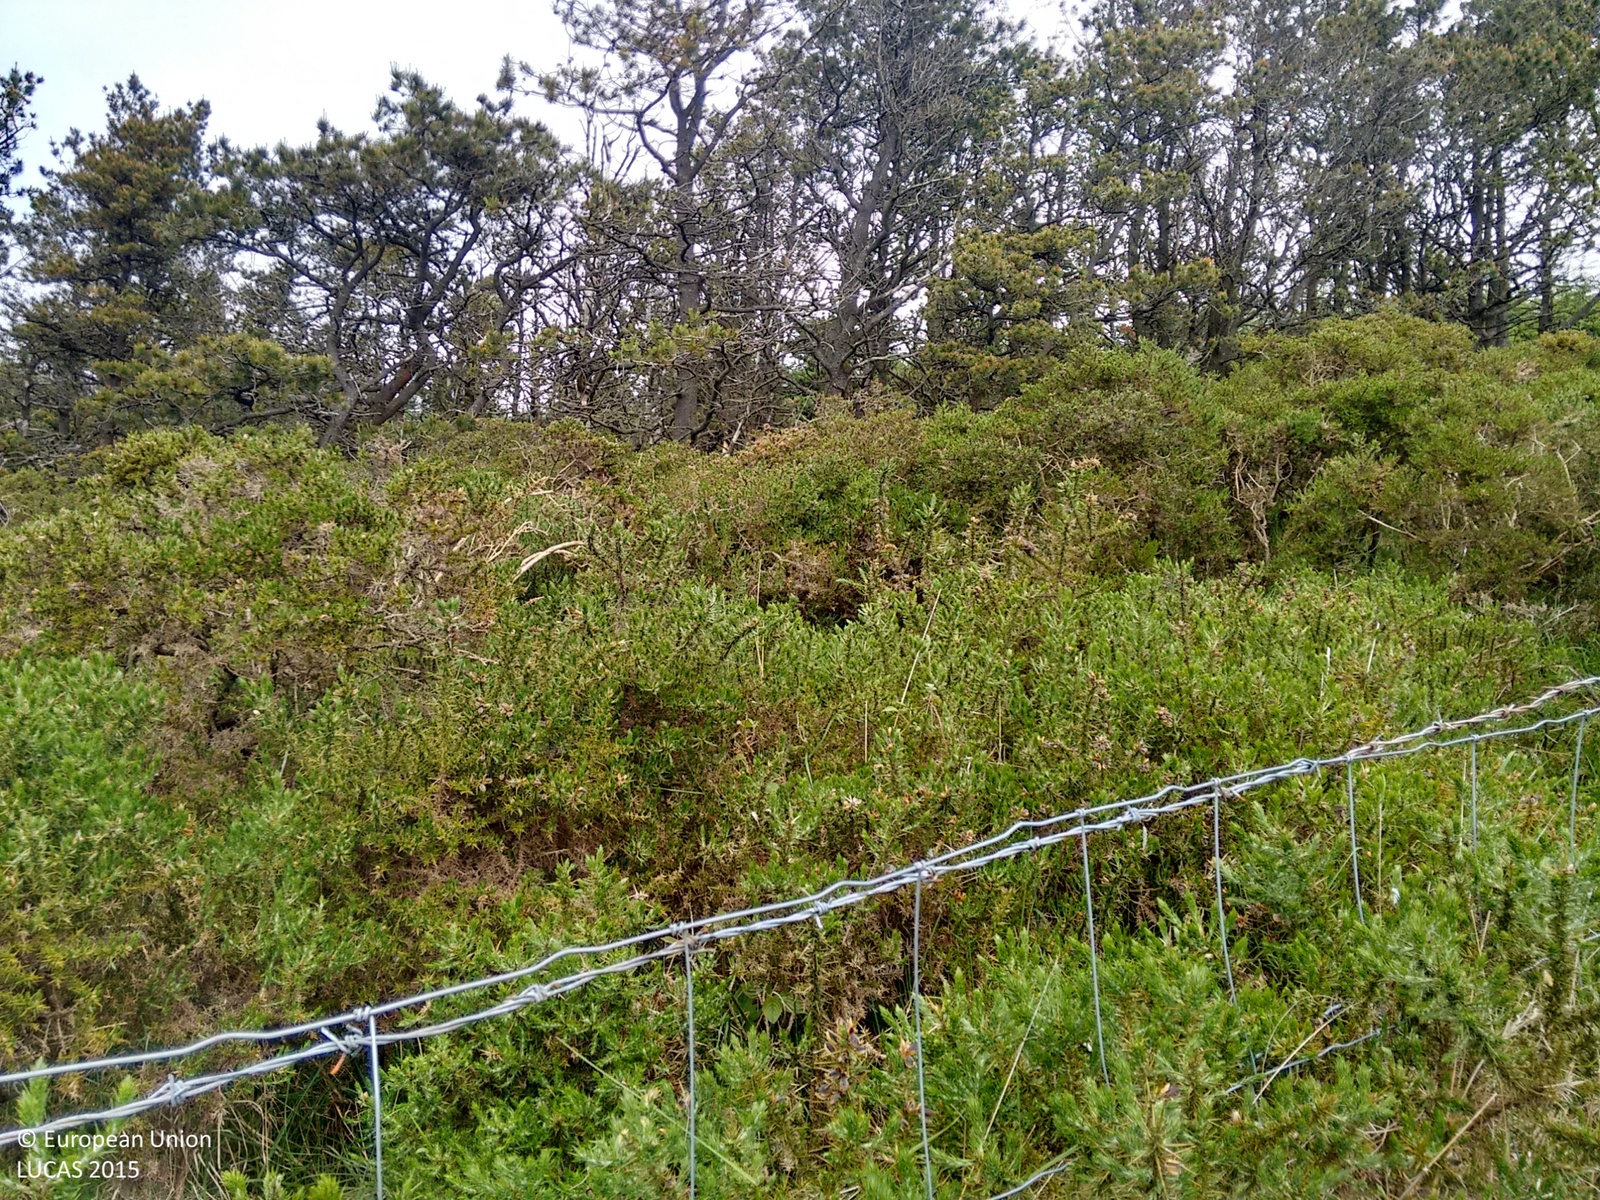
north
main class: Shrubland
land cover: Shrubland without tree cover
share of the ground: > 75 %
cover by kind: herbaceous plants 75 %, shrubs 25 %
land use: Agriculture (excluding fallow land and kitchen gardens)
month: June
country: IE
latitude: 53.2445
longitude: -6.4137
